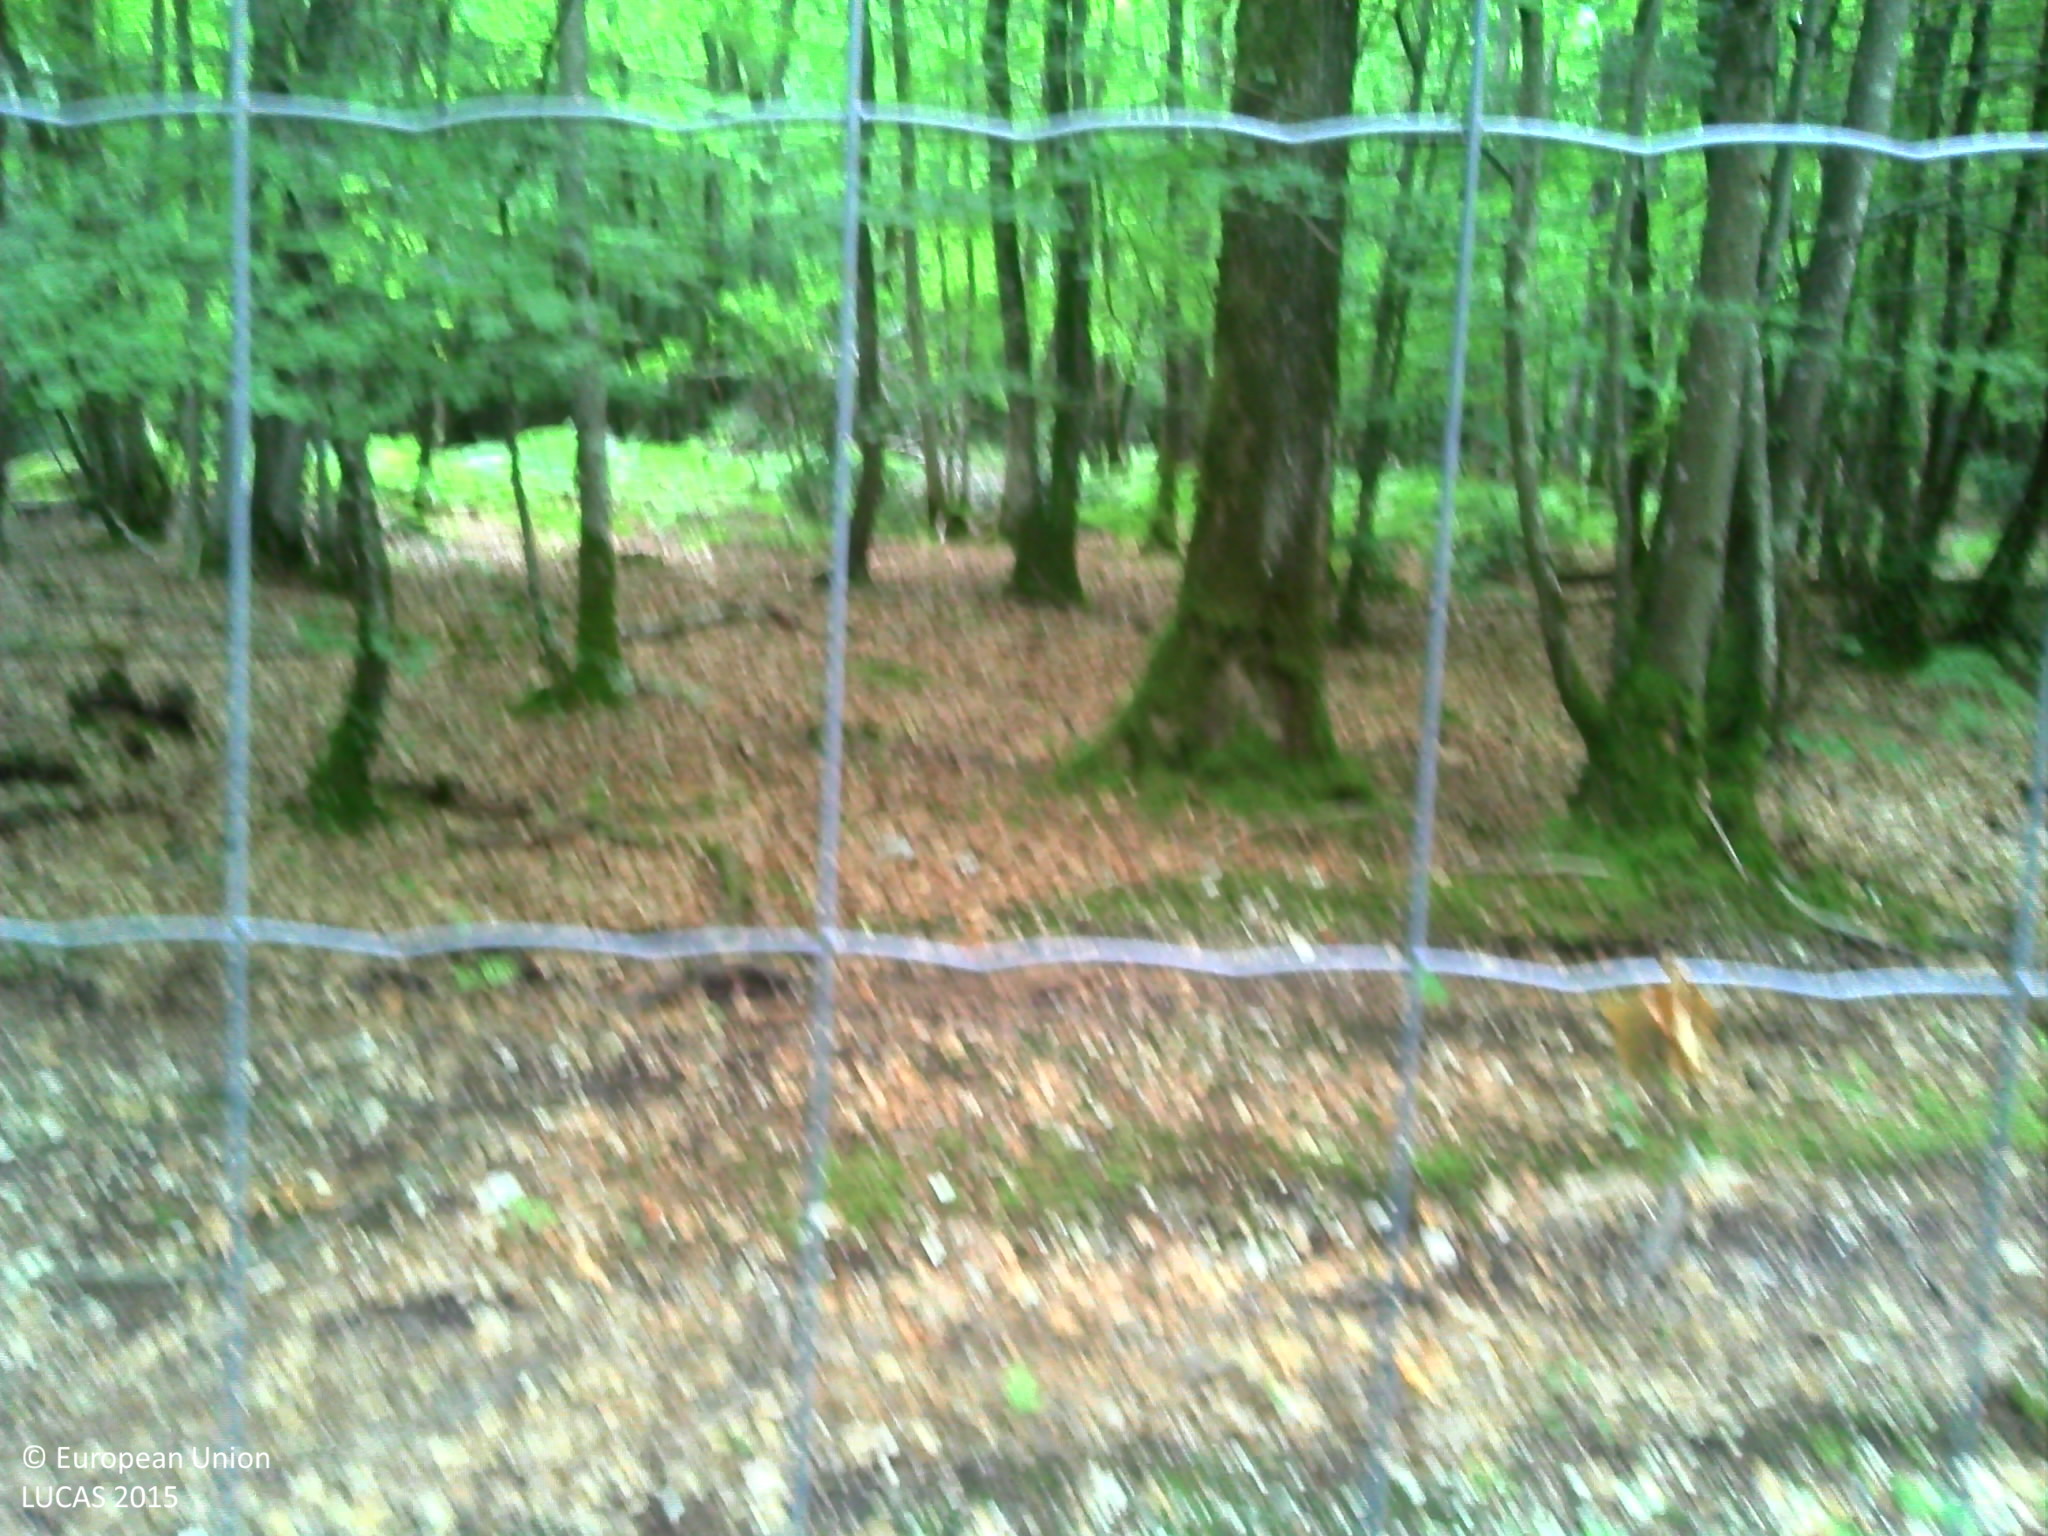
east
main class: Woodland
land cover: Broadleaved woodland
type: acidophilous oak and oak-birch forest
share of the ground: > 75 %
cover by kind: broadleaved forest trees 100 %
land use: Forestry
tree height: > 5 m
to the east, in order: Broadleaved woodland
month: June
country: FR
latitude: 47.4134
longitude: 2.5839
